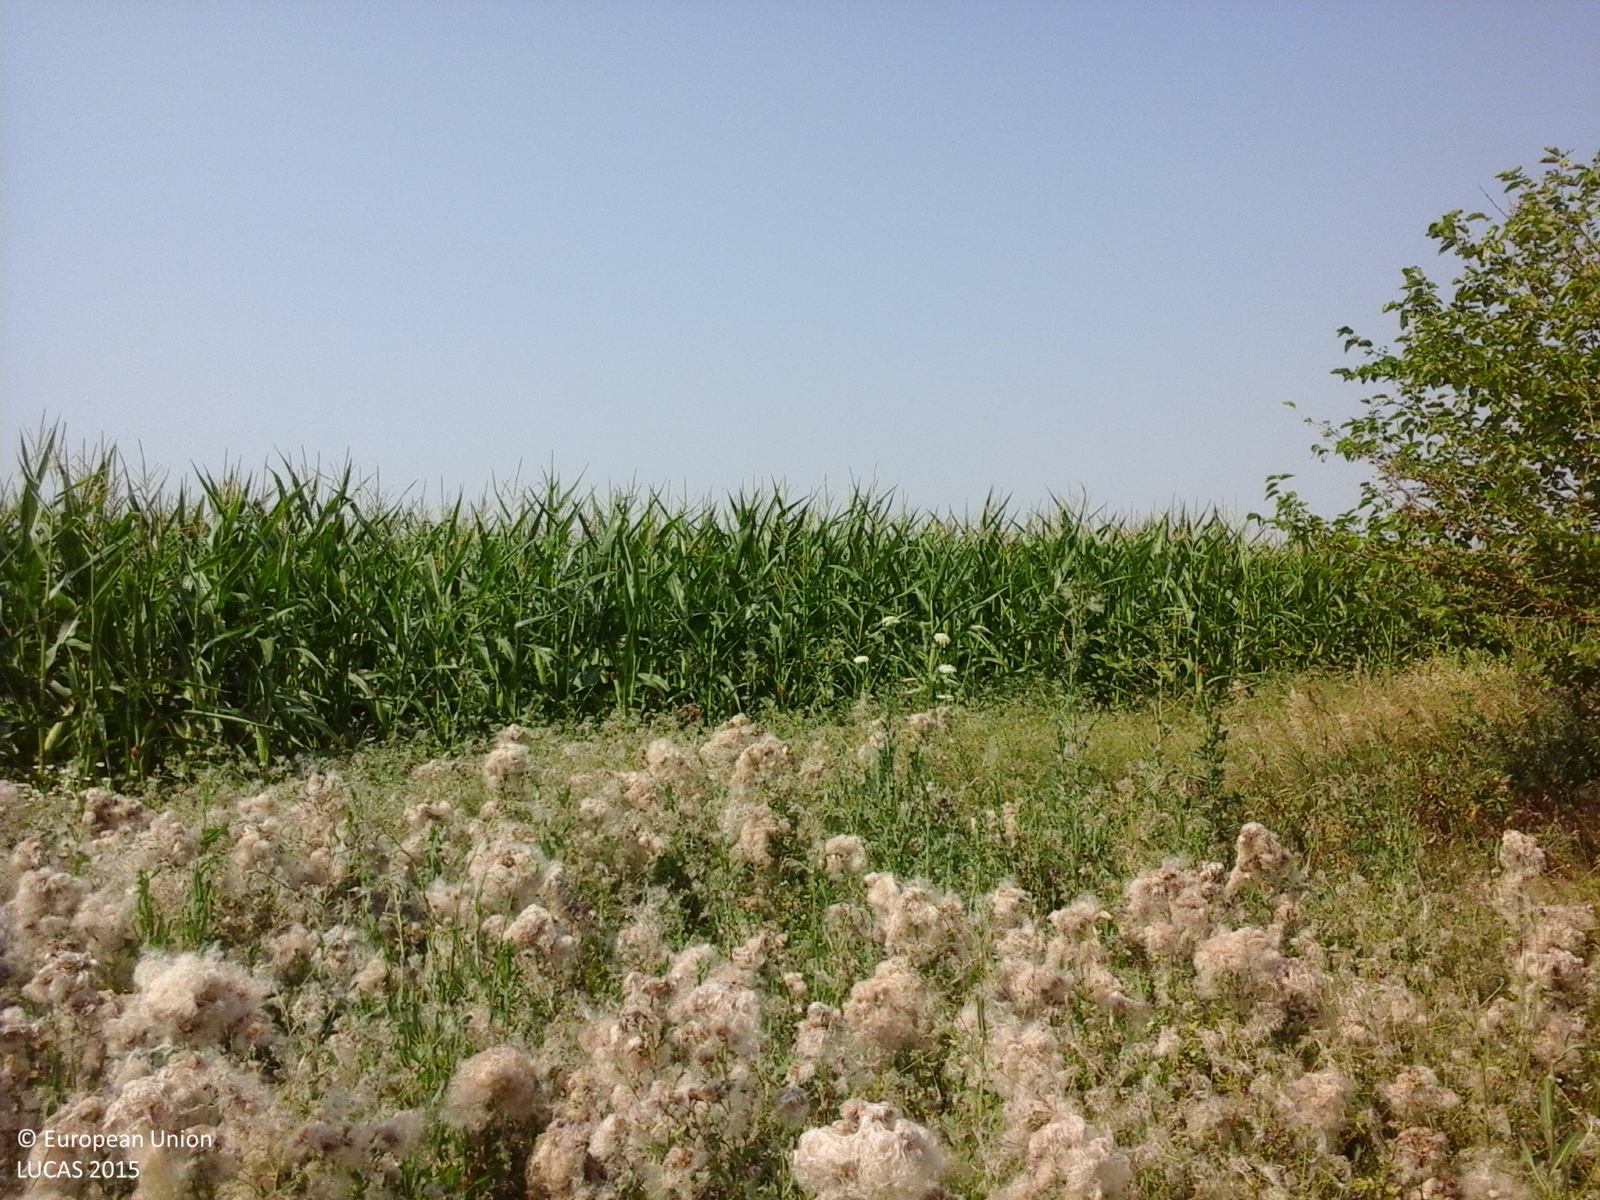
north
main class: Cropland
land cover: Maize
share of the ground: > 75 %
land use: Agriculture (excluding fallow land and kitchen gardens)
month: July
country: RO
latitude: 44.8168
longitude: 26.8586
